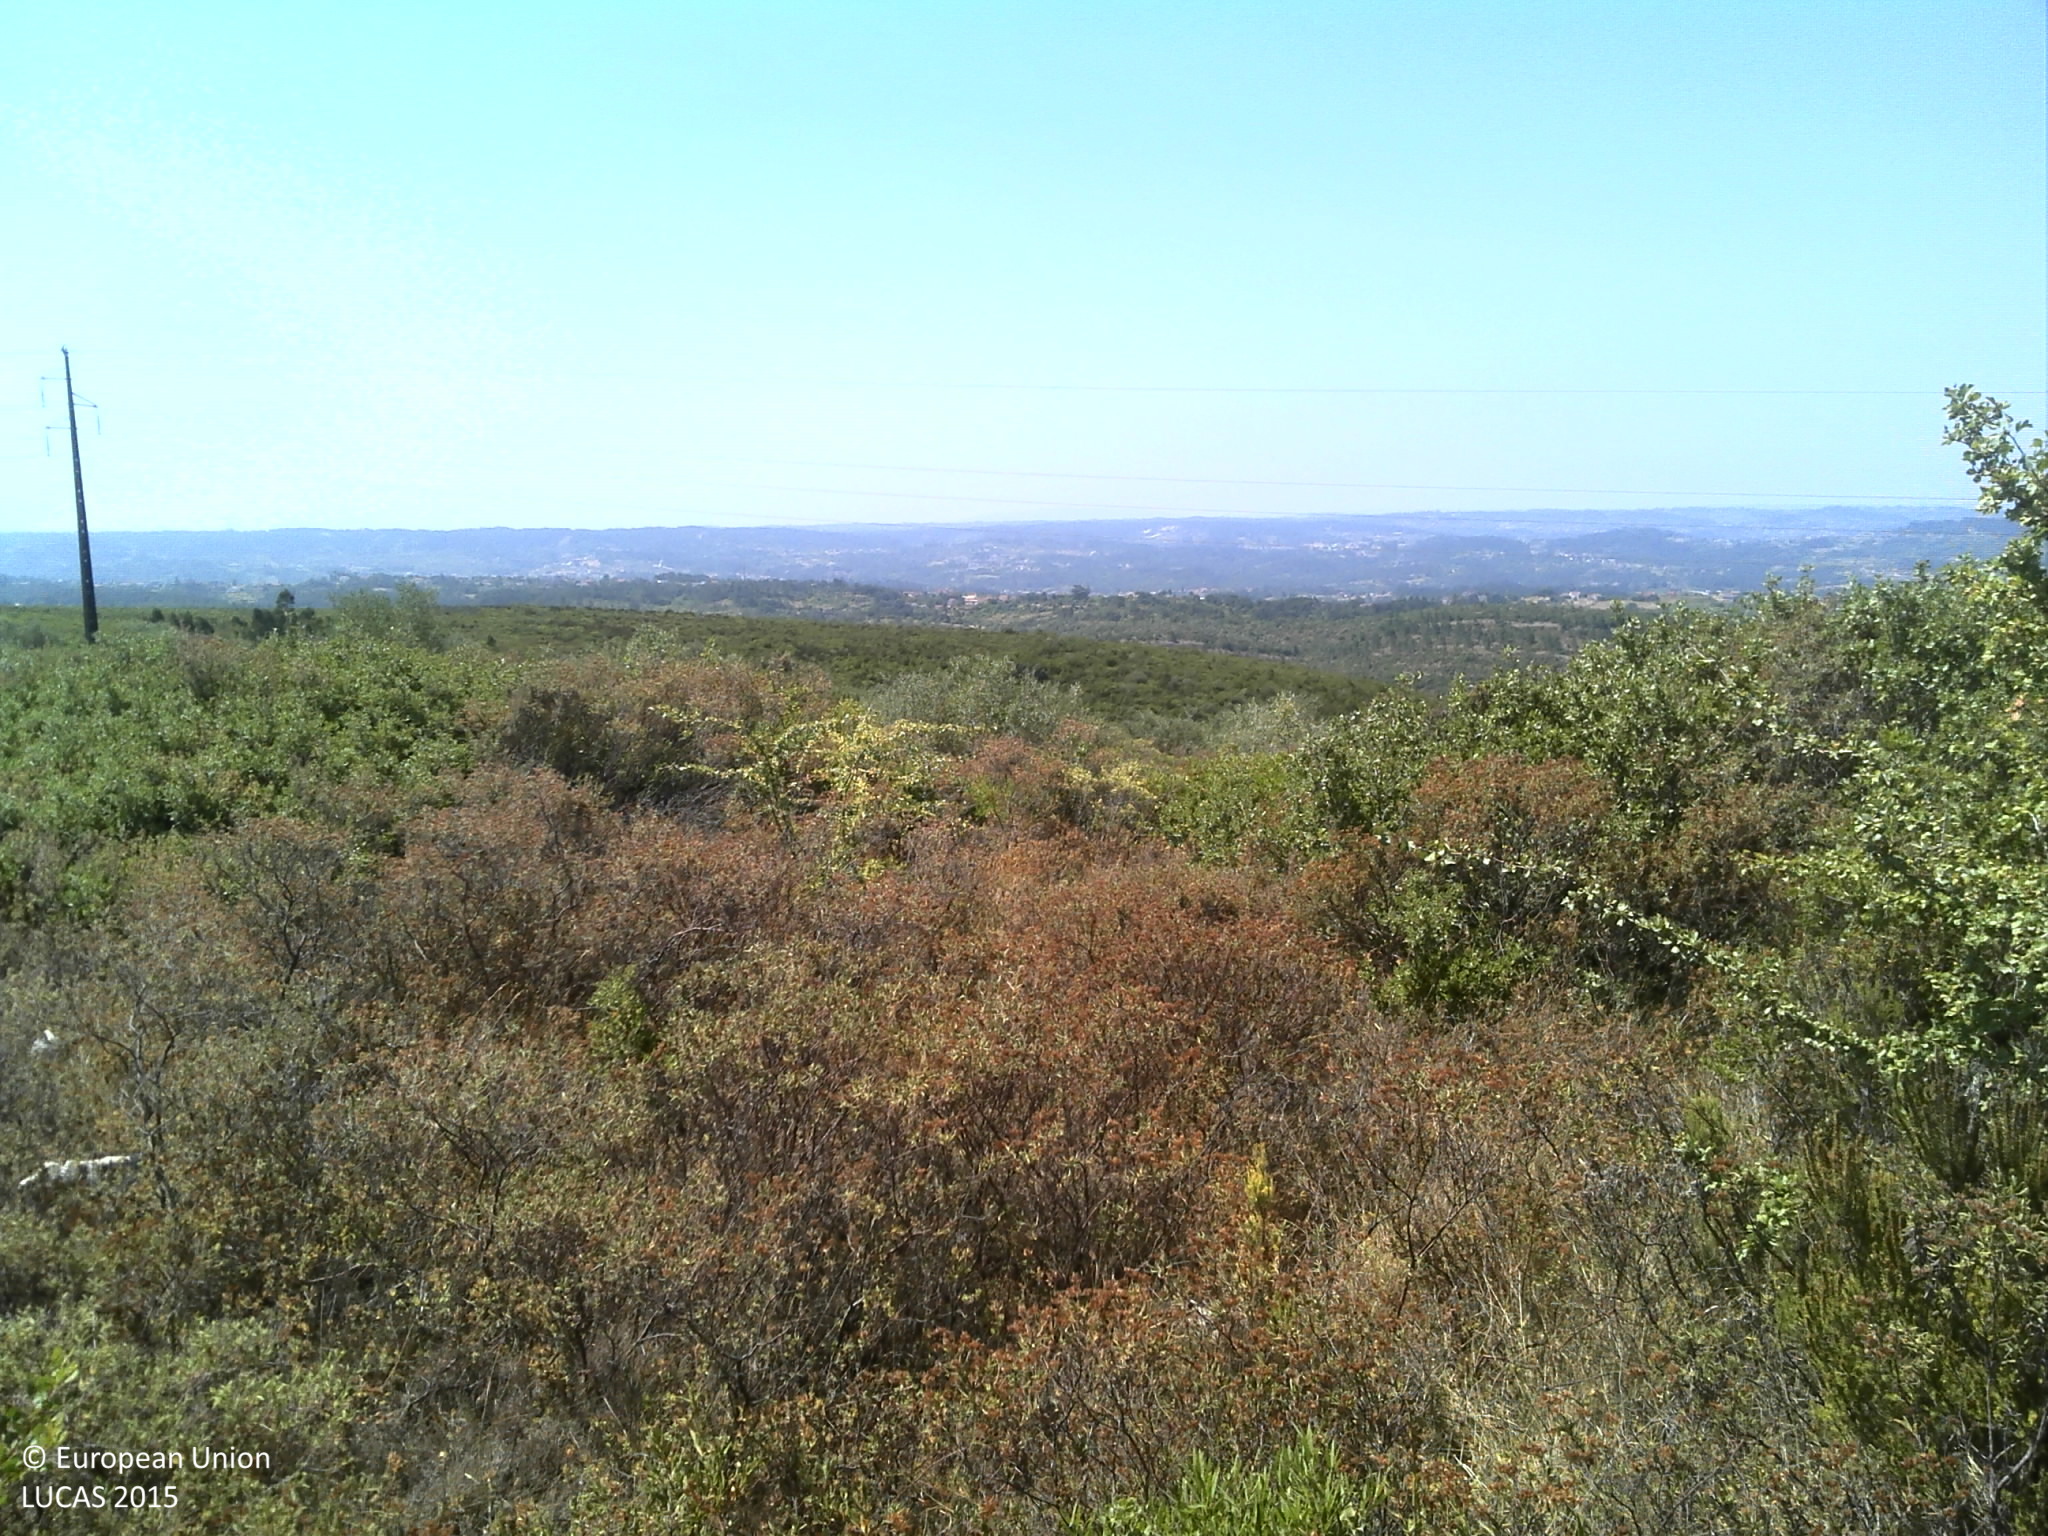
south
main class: Shrubland
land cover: Shrubland with sparse tree cover
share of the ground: 50 - 75 %
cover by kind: shrubs 75 %, unconsolidated bare surface 15 %, broadleaved forest trees 5 %, herbaceous plants 5 %
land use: Semi-natural and natural areas not in use
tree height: < 5 m
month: July
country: PT
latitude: 39.9184
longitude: -8.5793
